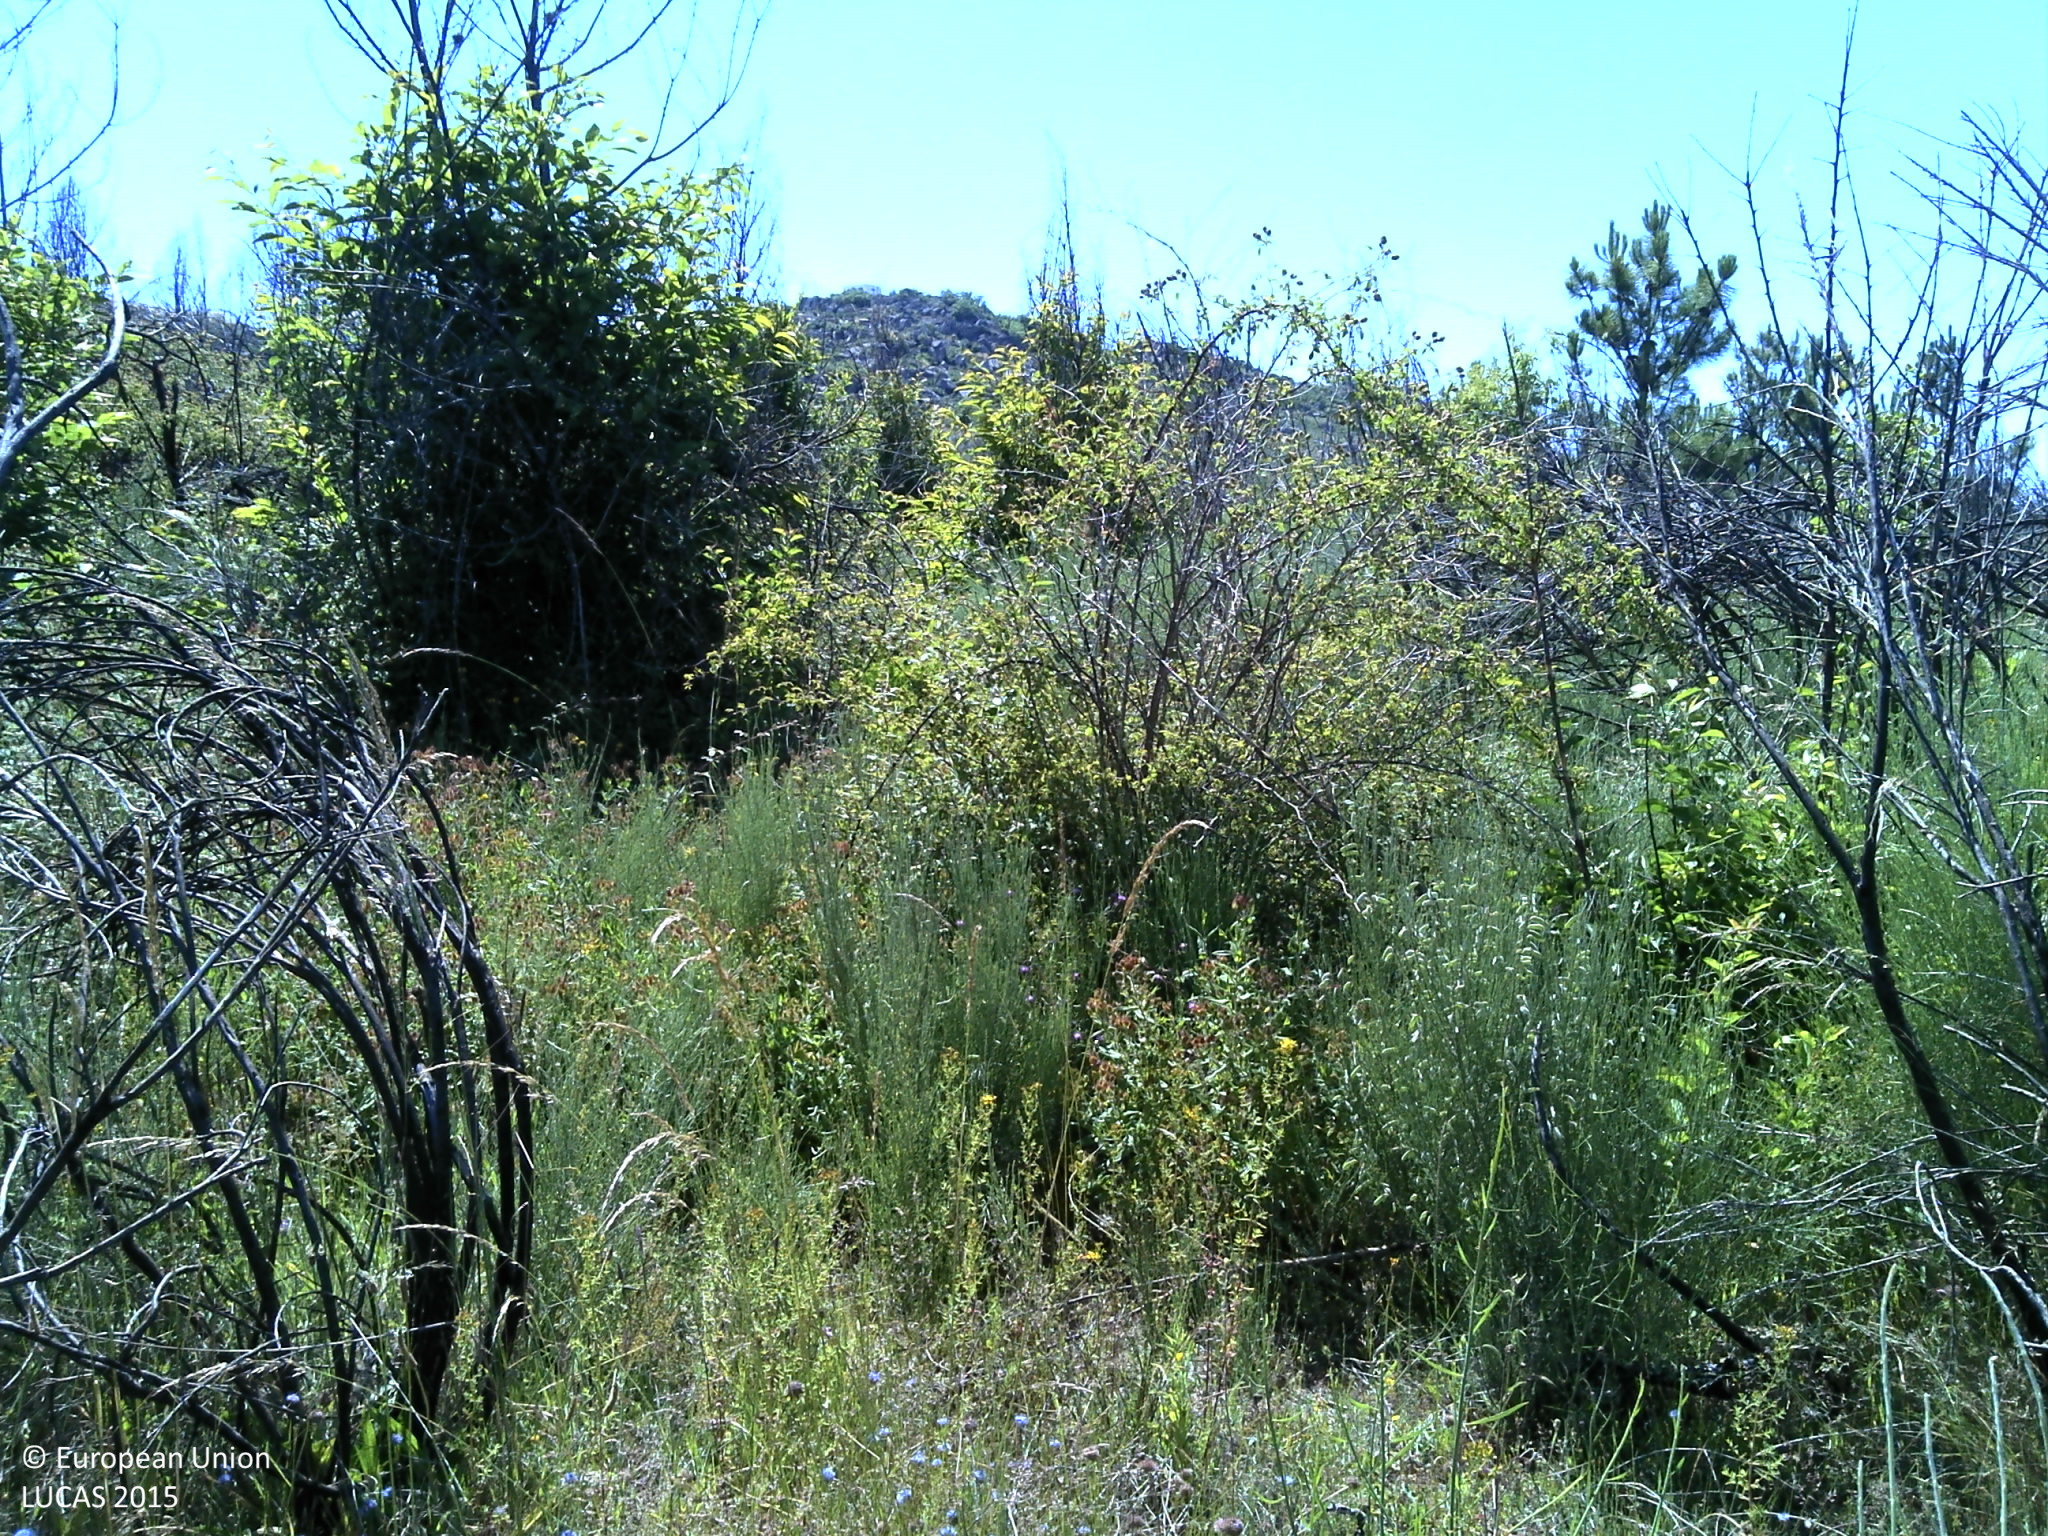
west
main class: Shrubland
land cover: Shrubland with sparse tree cover
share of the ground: 25 - 50 %
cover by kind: shrubs 40 %, unconsolidated bare surface 25 %, herbaceous plants 20 %, consolidated bare surface 10 %, broadleaved forest trees 5 %
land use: Forestry
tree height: < 5 m
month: June
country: PT
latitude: 41.0301
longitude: -7.5699
